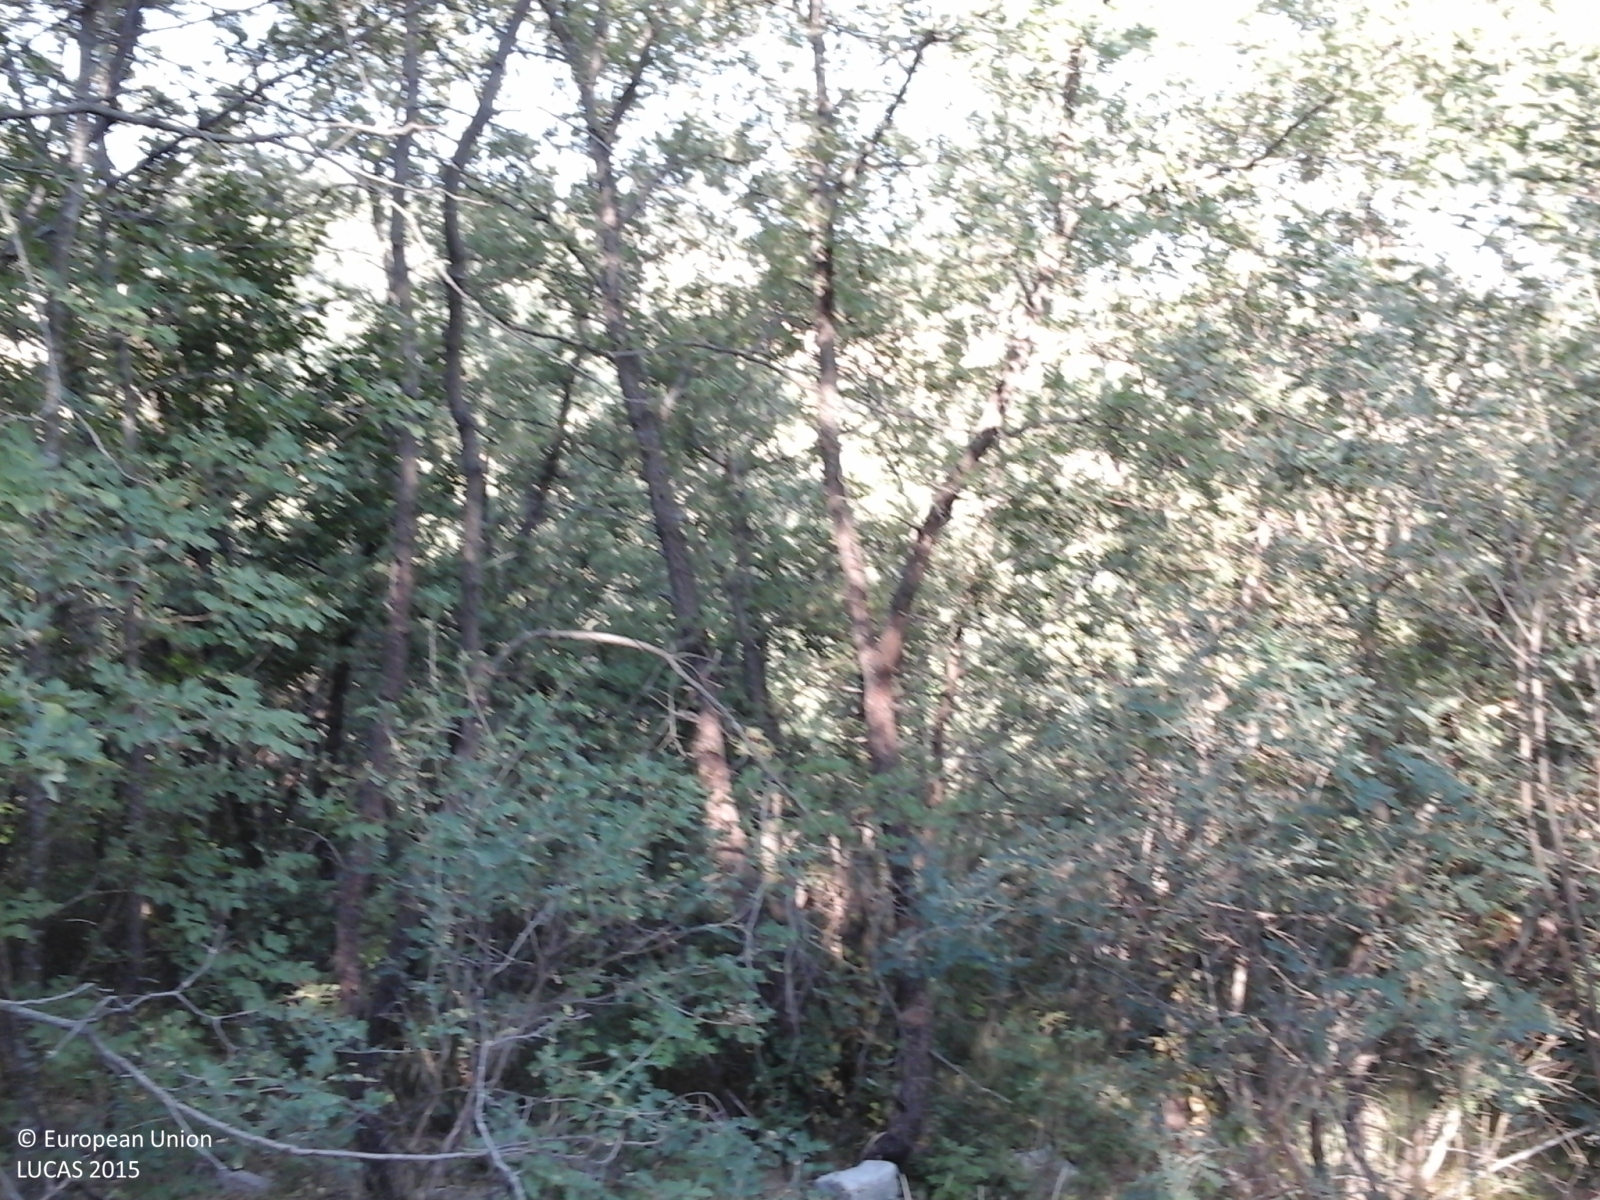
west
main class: Woodland
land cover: Broadleaved woodland
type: thermophilous deciduous forest
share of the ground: > 75 %
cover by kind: broadleaved forest trees 90 %, shrubs 5 %, herbaceous plants 5 %
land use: Semi-natural and natural areas not in use
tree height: > 5 m
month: July
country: IT
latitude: 41.5296
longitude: 14.7415
